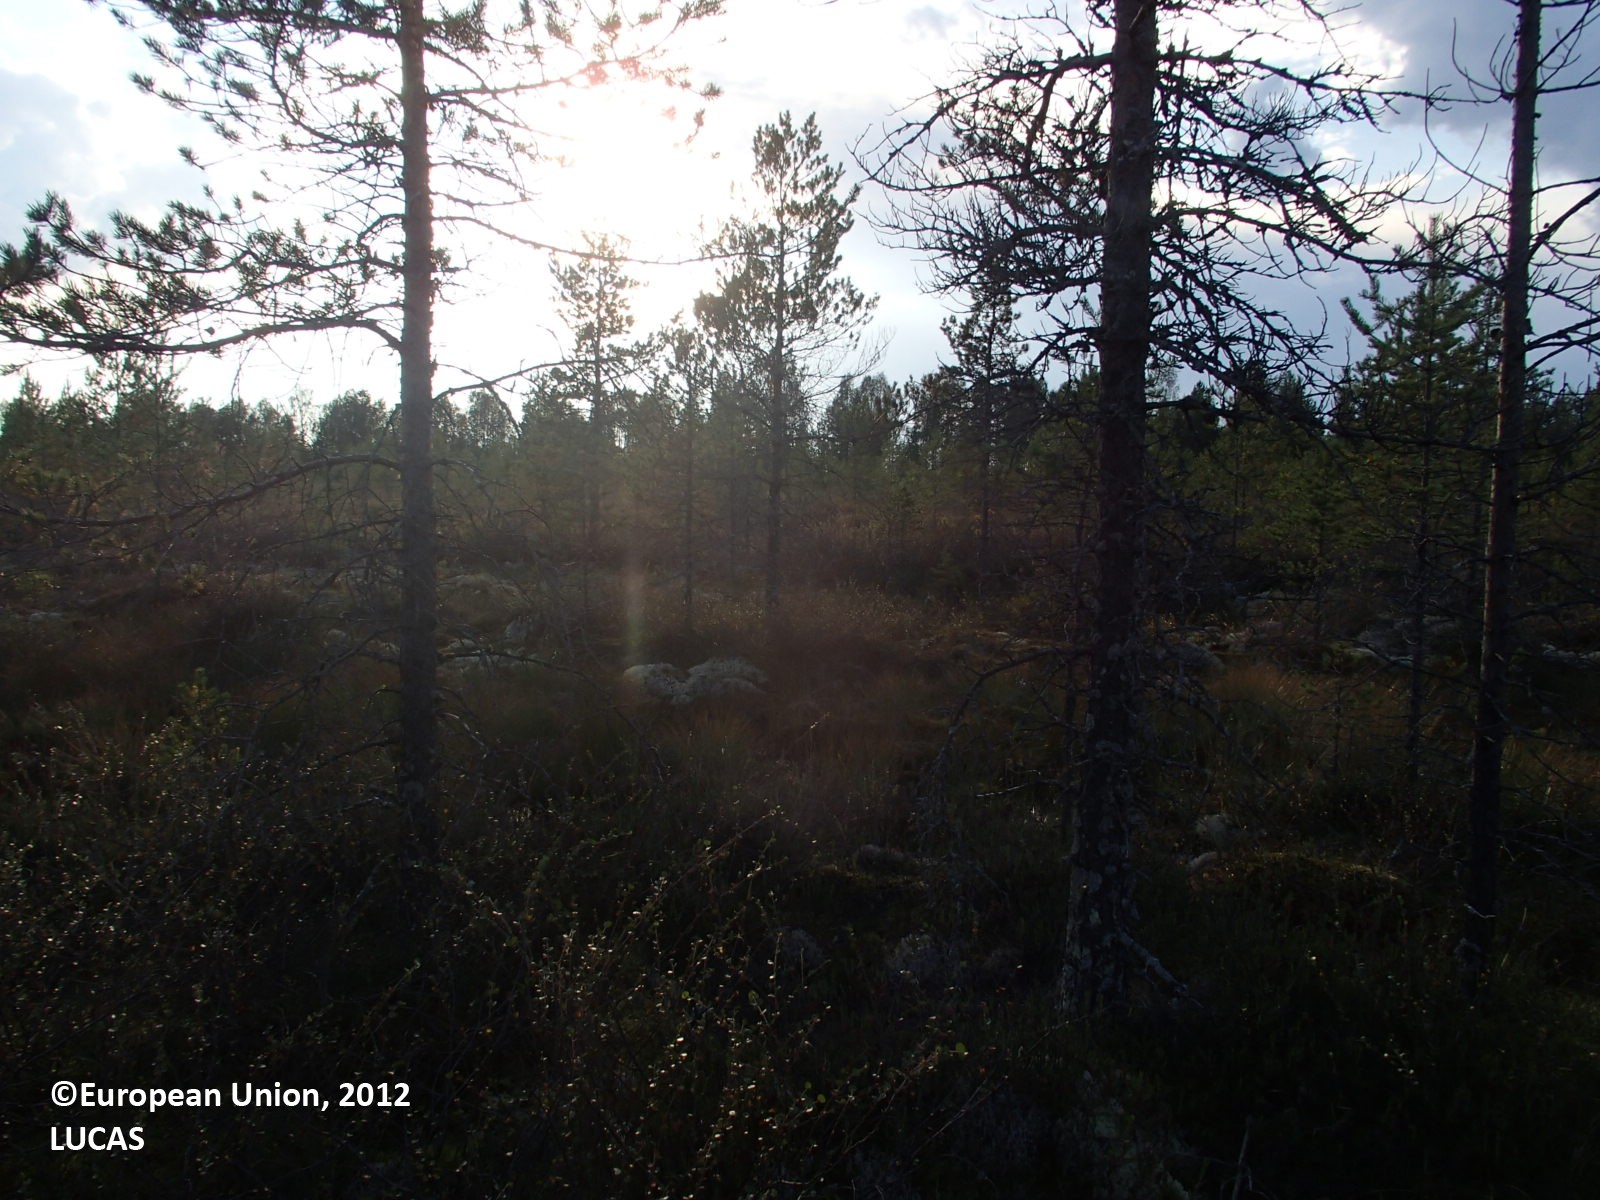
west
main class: Woodland
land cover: Pine dominated coniferous woodland
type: boreal forest
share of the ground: 25 - 50 %
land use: Forestry
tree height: < 5 m
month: August
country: FI
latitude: 63.9438
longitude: 26.0458
